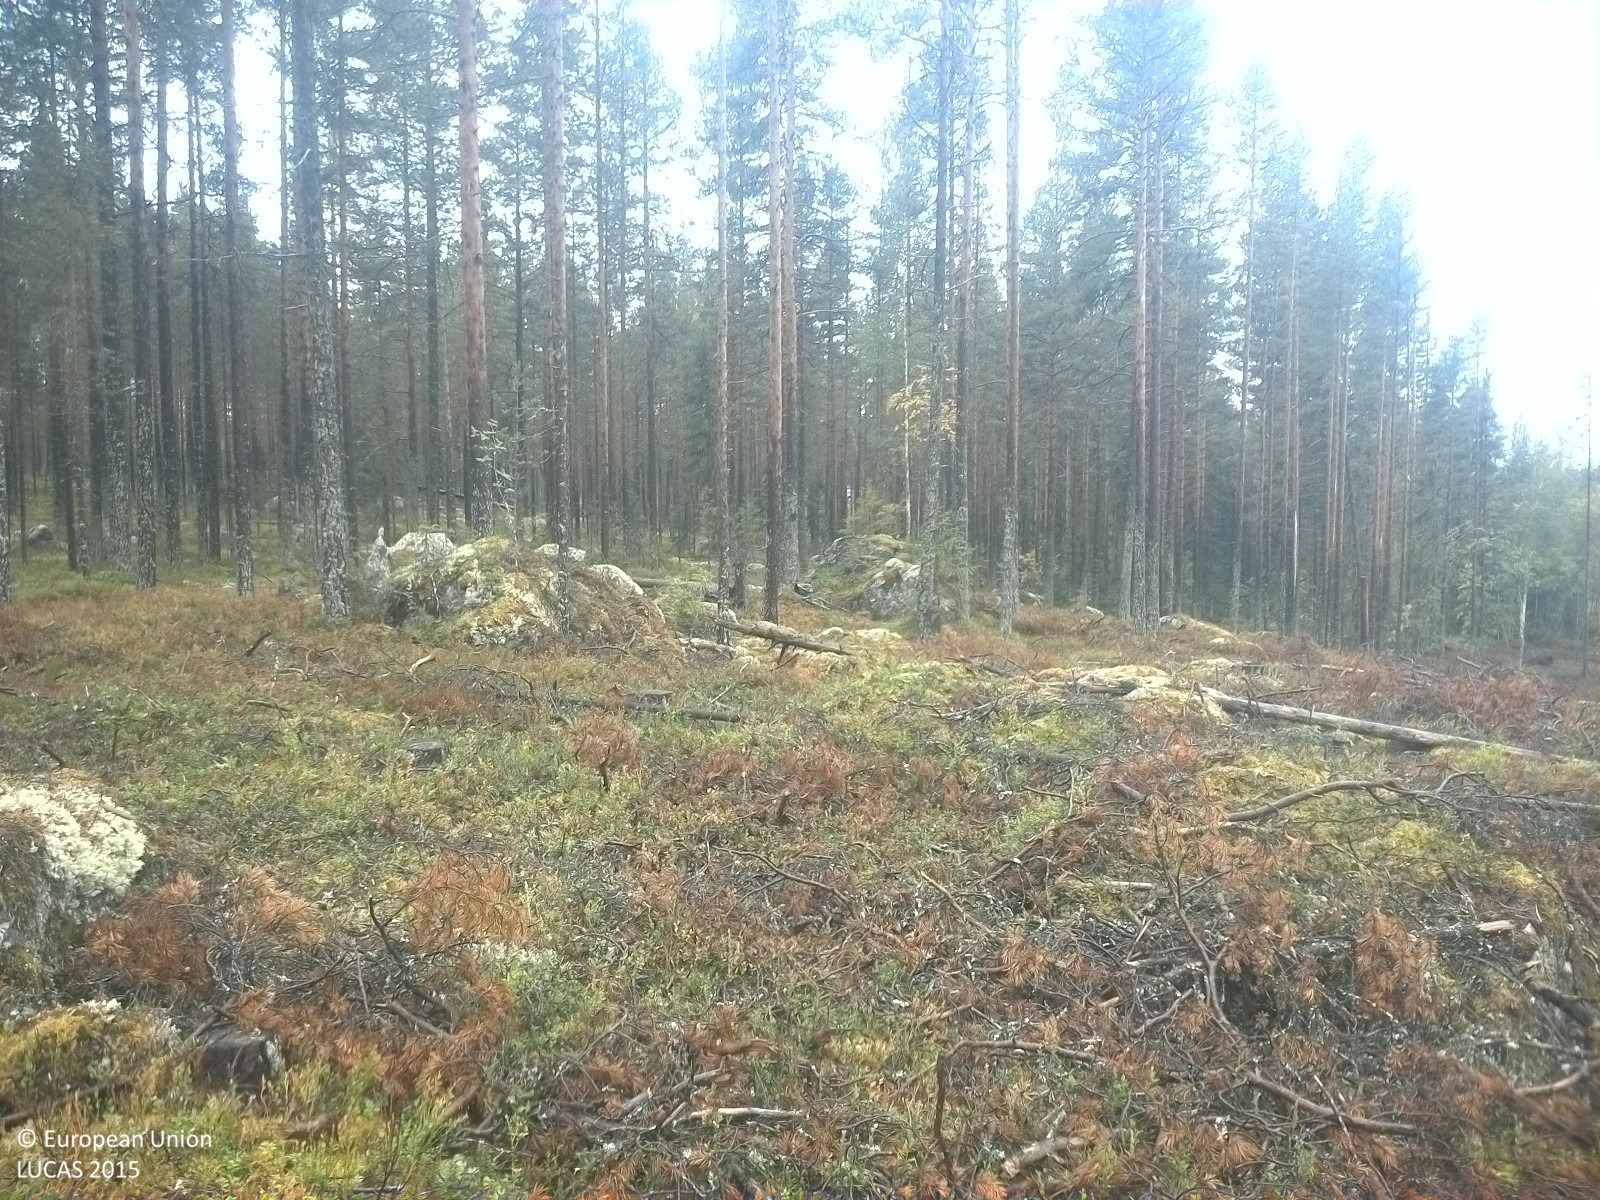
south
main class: Grassland
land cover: Grassland with sparse tree/shrub cover
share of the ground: > 75 %
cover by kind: herbaceous plants 95 %, broadleaved forest trees 5 %
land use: Residential
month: September
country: SE
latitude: 62.1617
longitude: 15.6821
